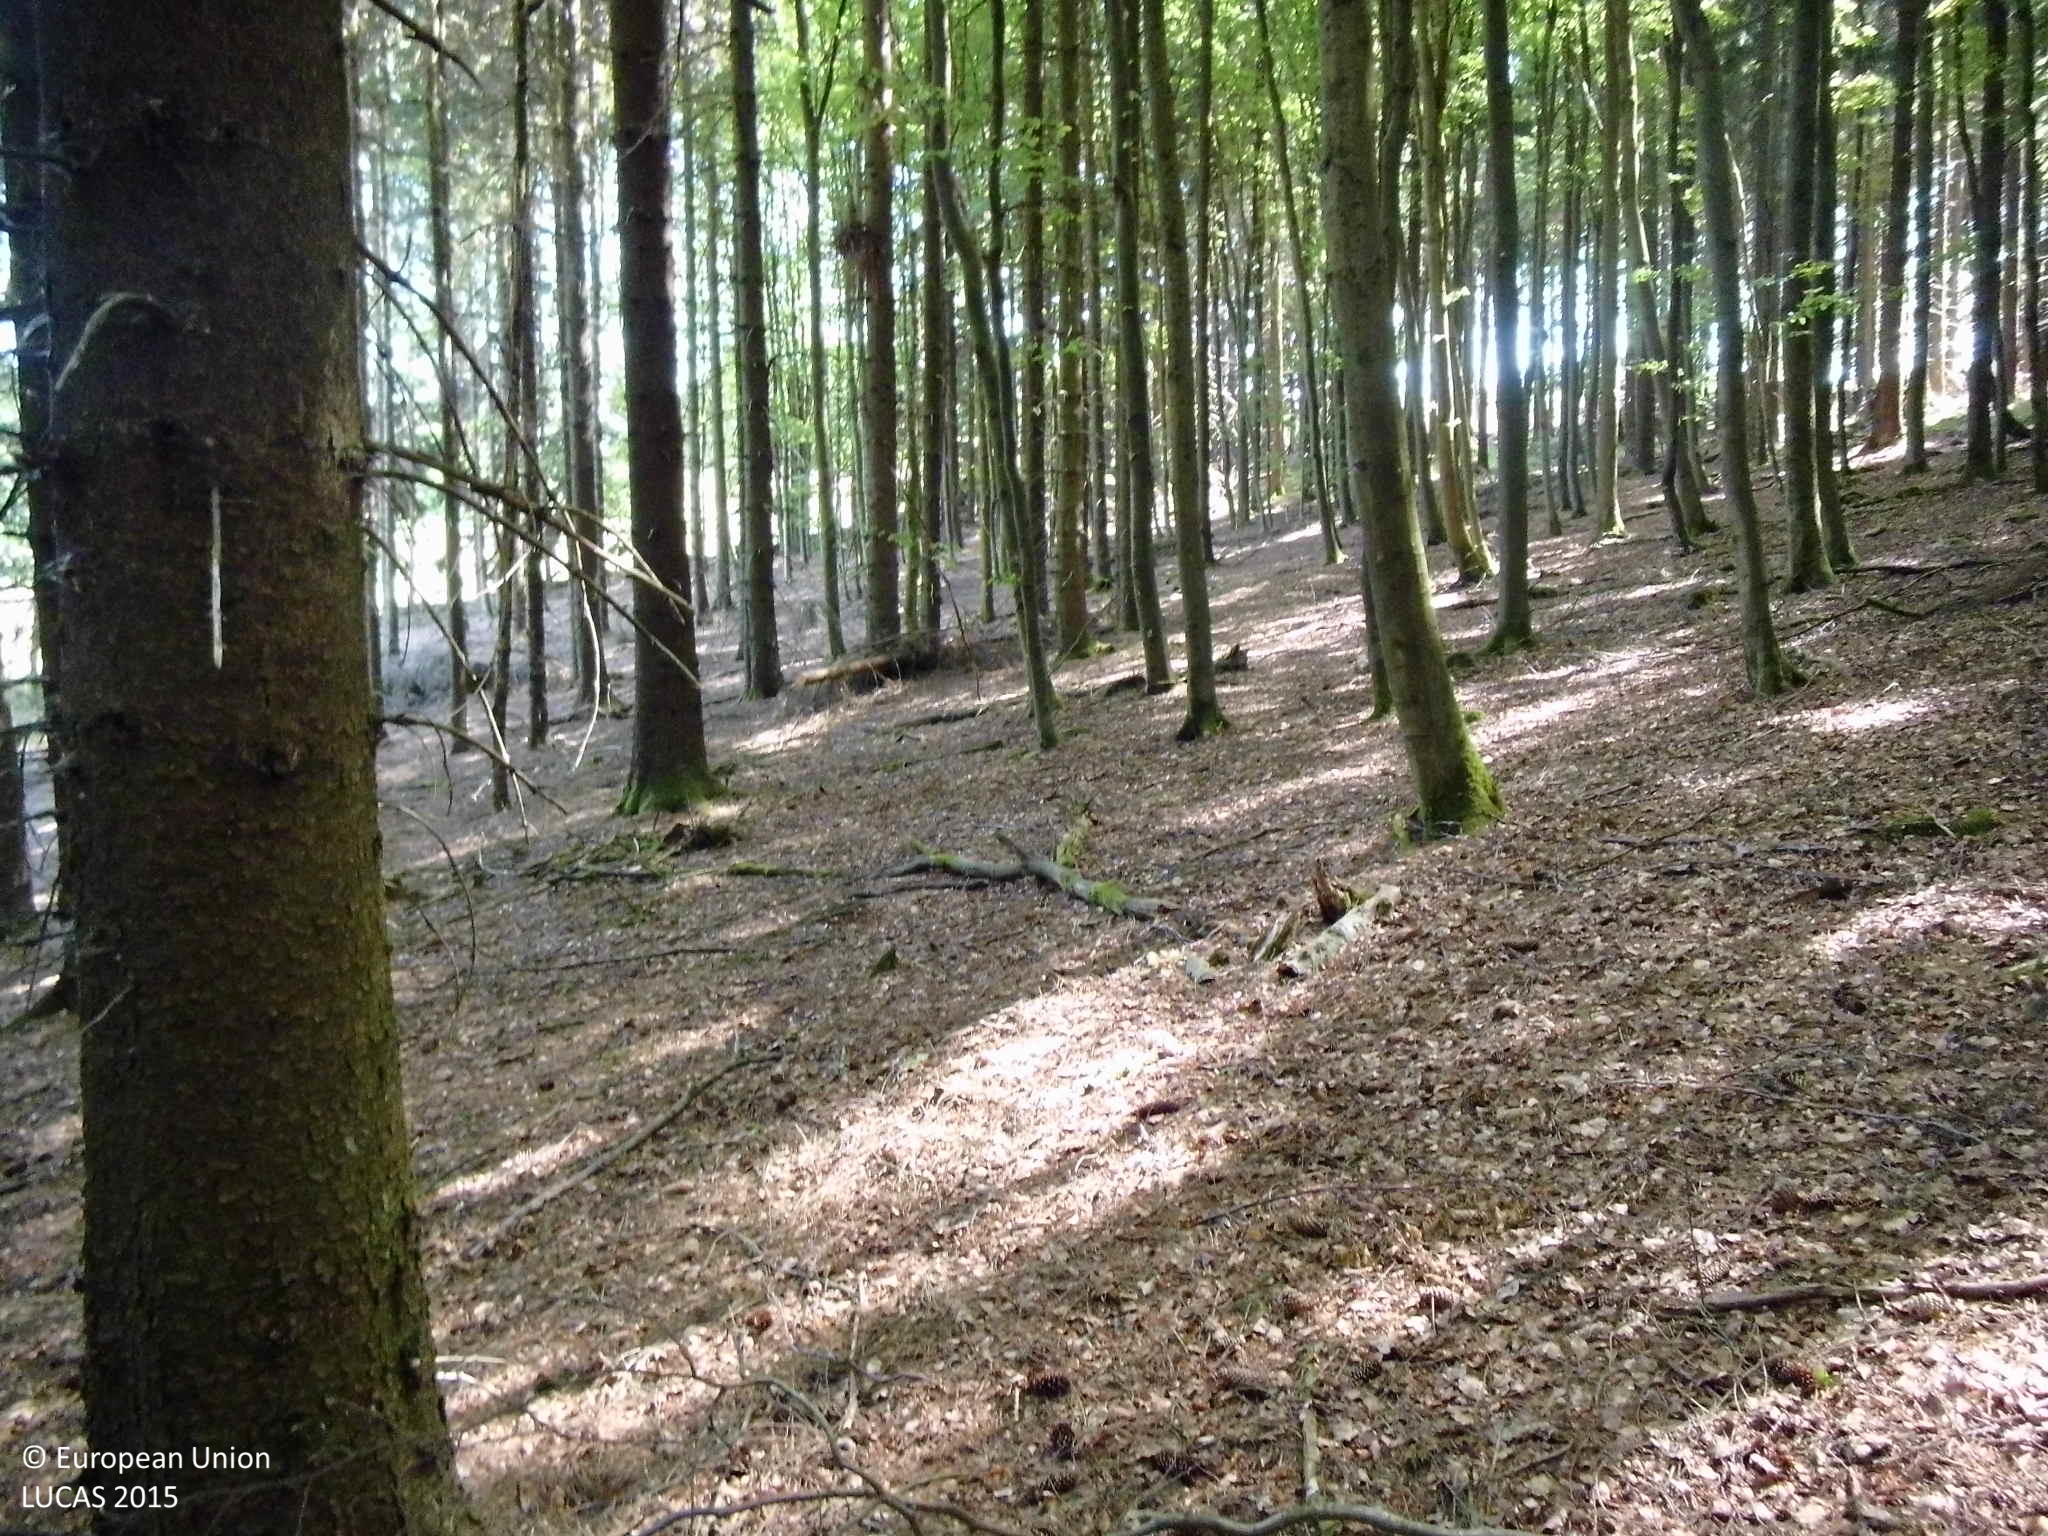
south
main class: Woodland
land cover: Spruce dominated mixed woodland
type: hemiboreal forest and nemoral coniferous forest and mixed broadleaved-coniferous forest
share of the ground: > 75 %
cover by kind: coniferous forest trees 55 %, broadleaved forest trees 45 %
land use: Forestry
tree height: > 5 m
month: June
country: DE
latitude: 50.9481
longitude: 8.5343
